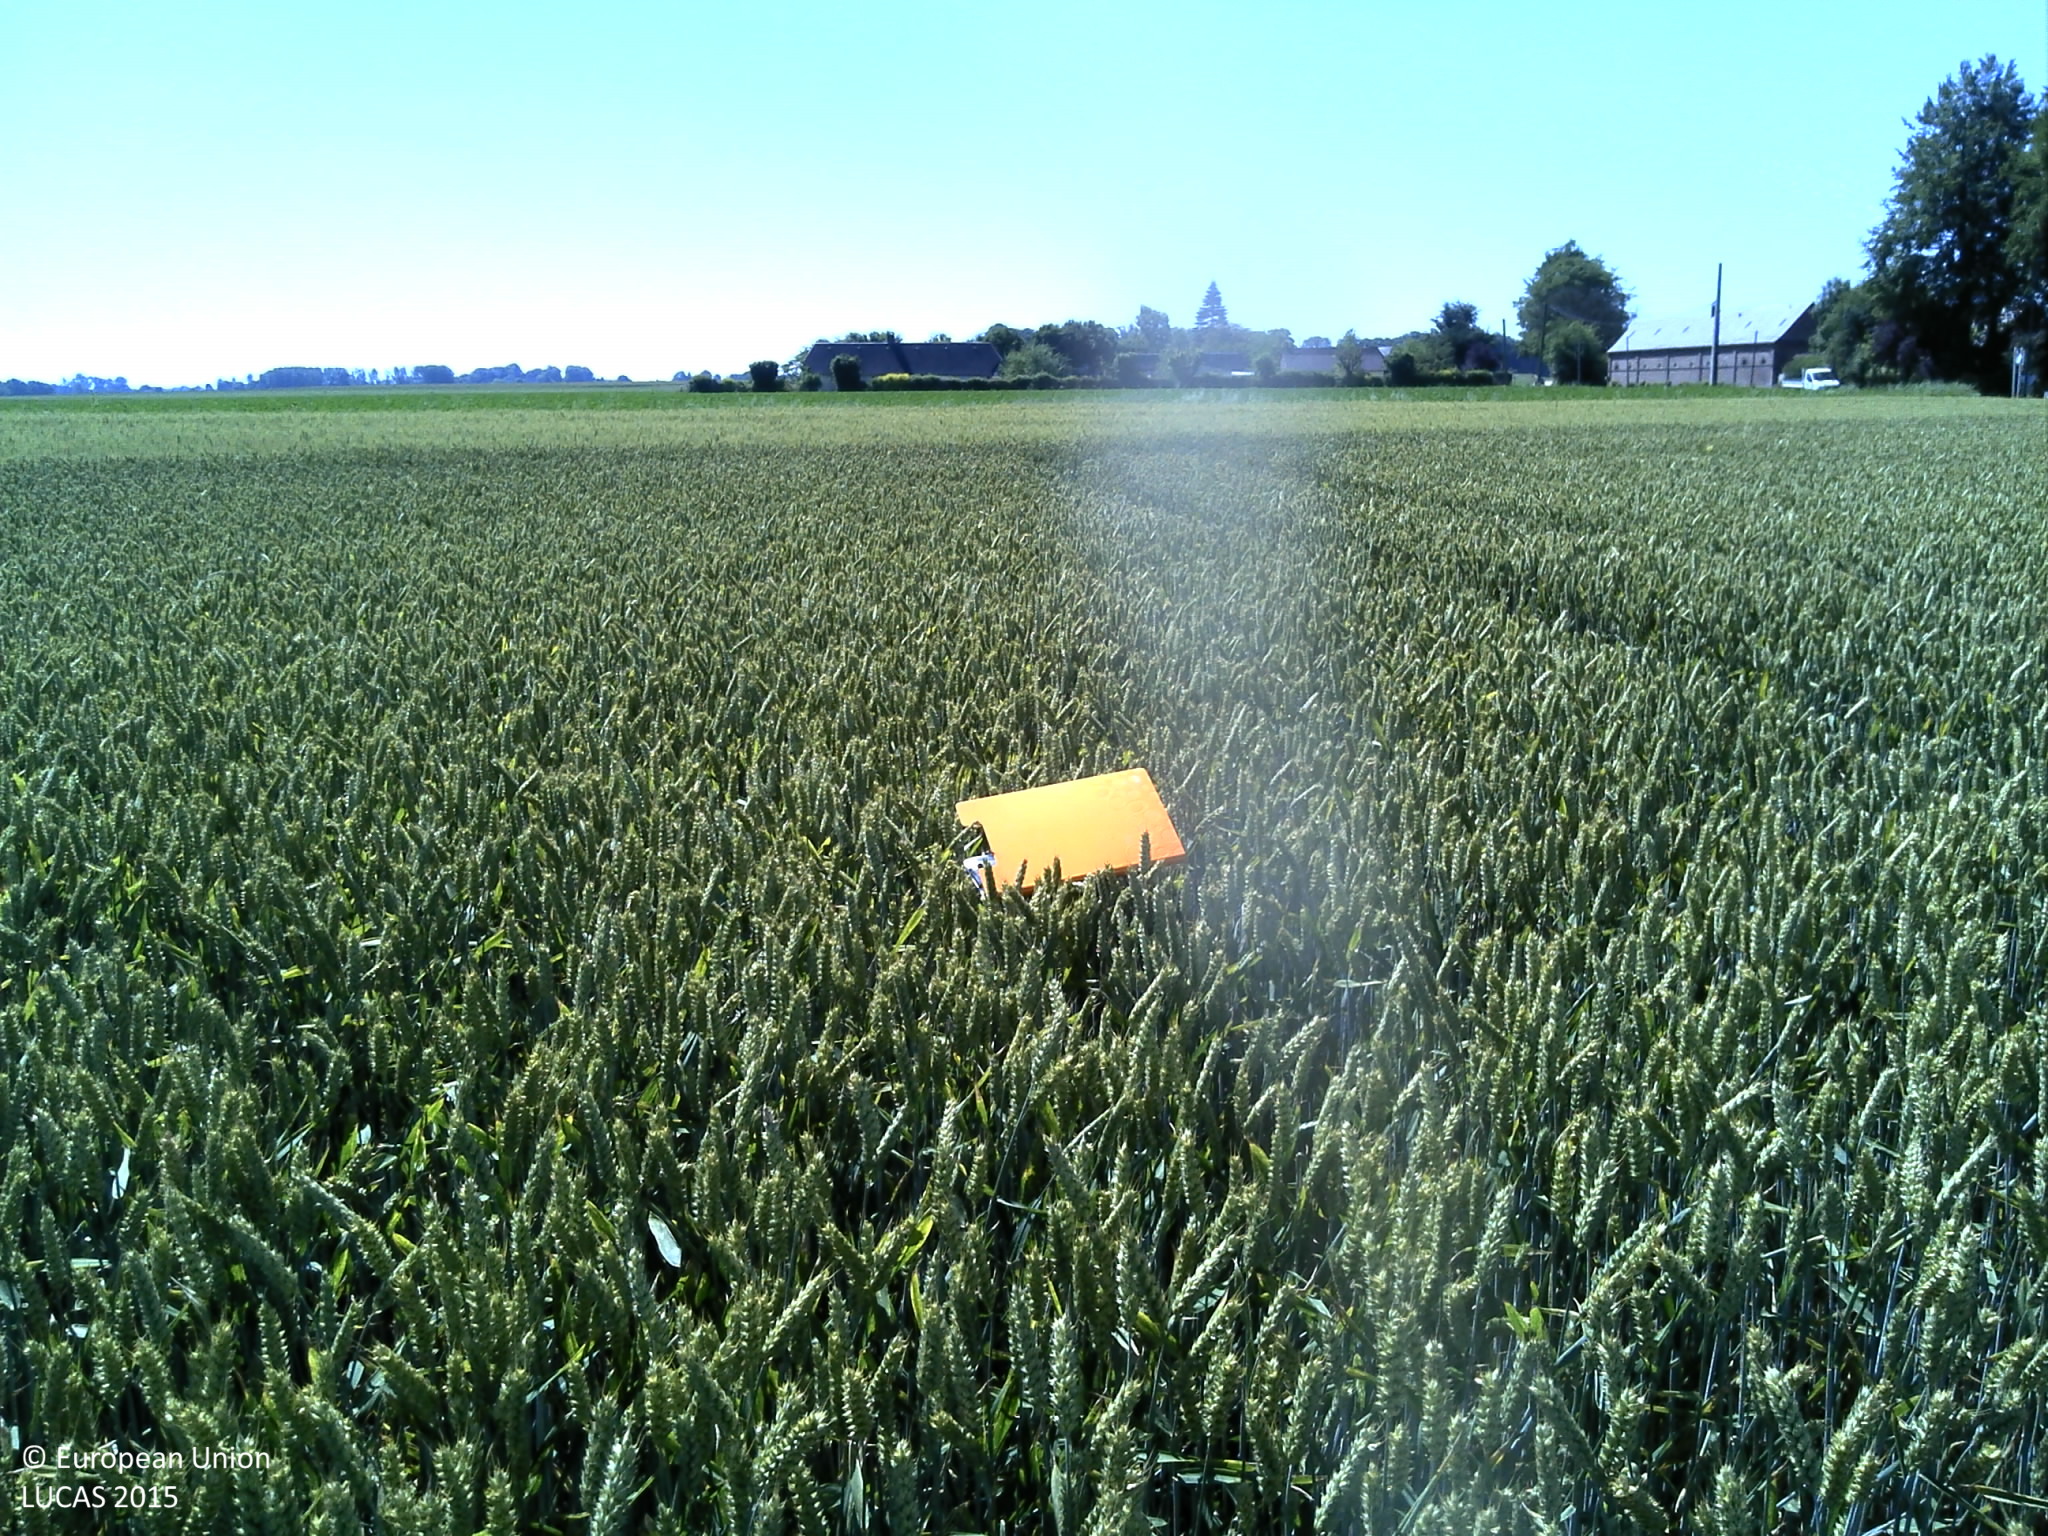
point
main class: Cropland
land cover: Common wheat
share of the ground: > 75 %
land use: Agriculture (excluding fallow land and kitchen gardens)
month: June
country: FR
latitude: 49.8464
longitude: 1.0075
